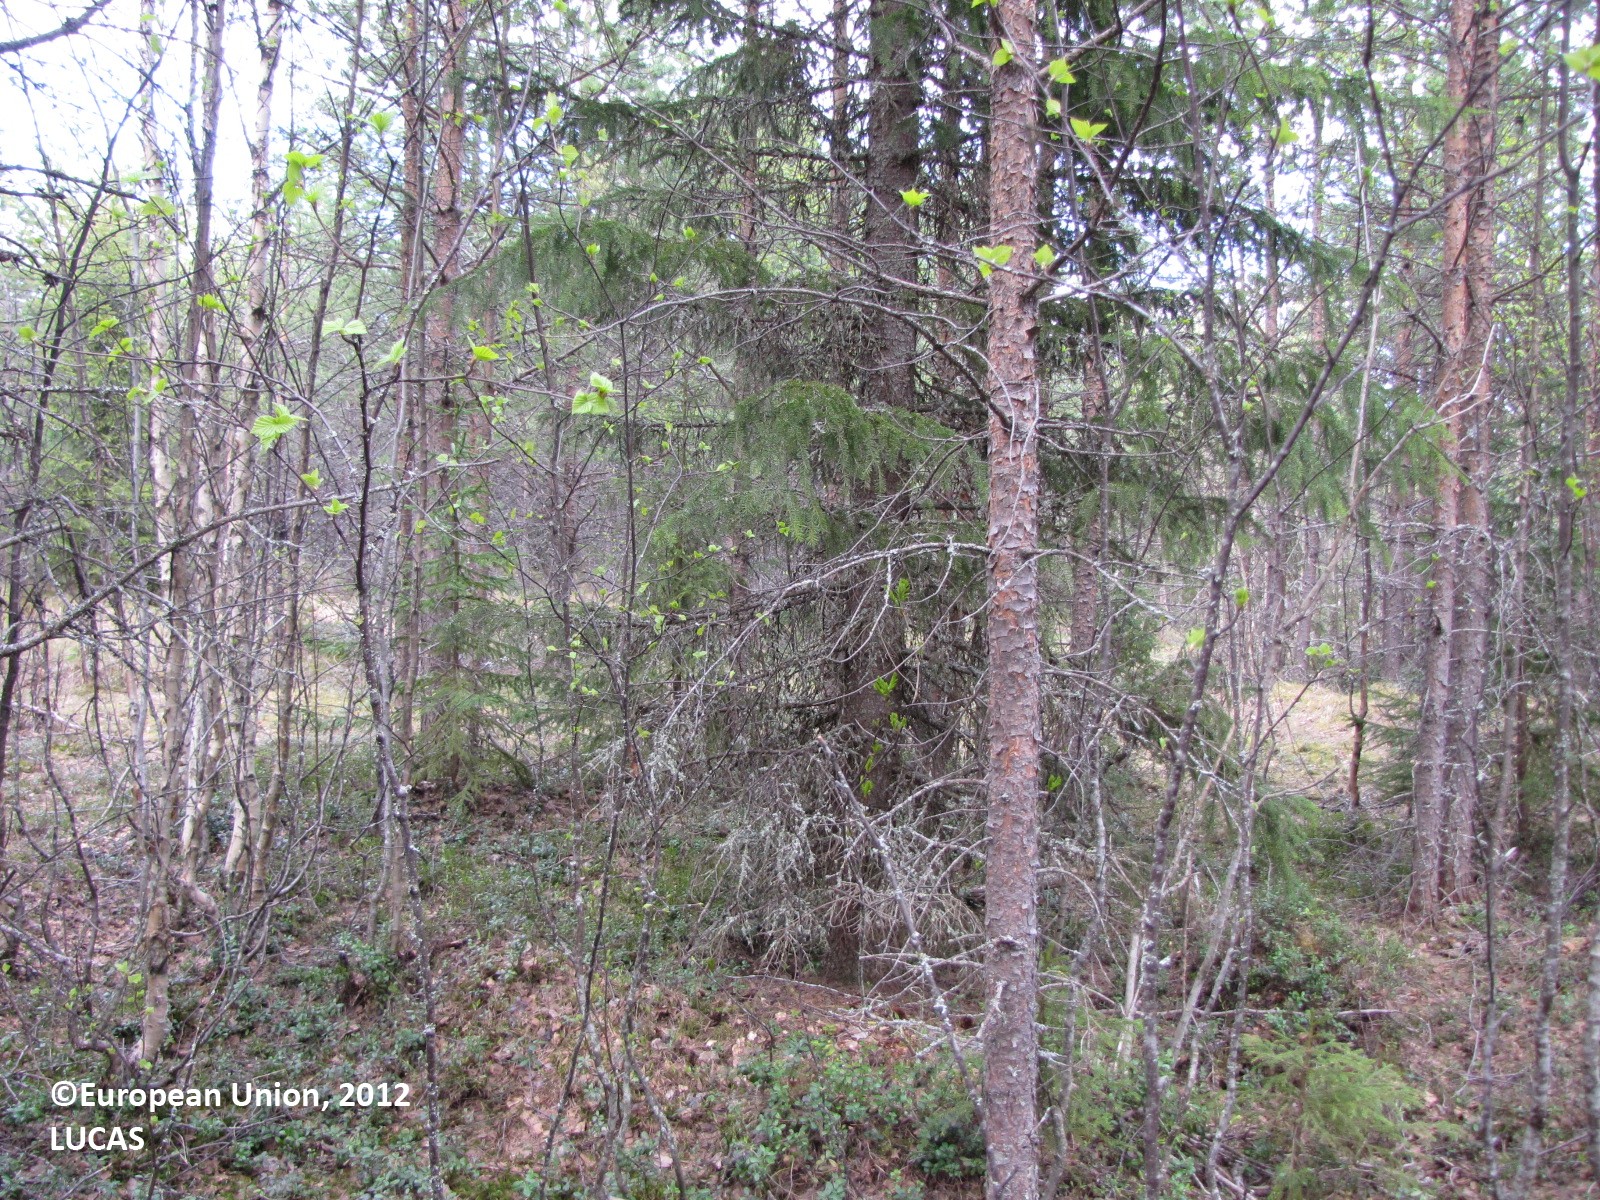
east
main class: Woodland
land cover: Other mixed woodland
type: boreal forest
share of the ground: > 75 %
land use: Forestry
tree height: > 5 m
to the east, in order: Other mixed woodland; Pine dominated mixed woodland; Tracks; Pine dominated mixed woodland; Ditches and canals; Pine dominated mixed woodland; Ditches and canals; Pine dominated mixed woodland; Ditches and canals; Pine dominated mixed woodland; Ditches and canals; Pine dominated mixed woodland; Ditches and canals; Pine dominated mixed woodland; Ditches and canals; Pine dominated mixed woodland; Ditches and canals; Pine dominated mixed woodland; Ditches and canals; Pine dominated mixed woodland; Ditches and canals; Pine dominated mixed woodland
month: May
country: FI
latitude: 65.7218
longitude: 24.6833
